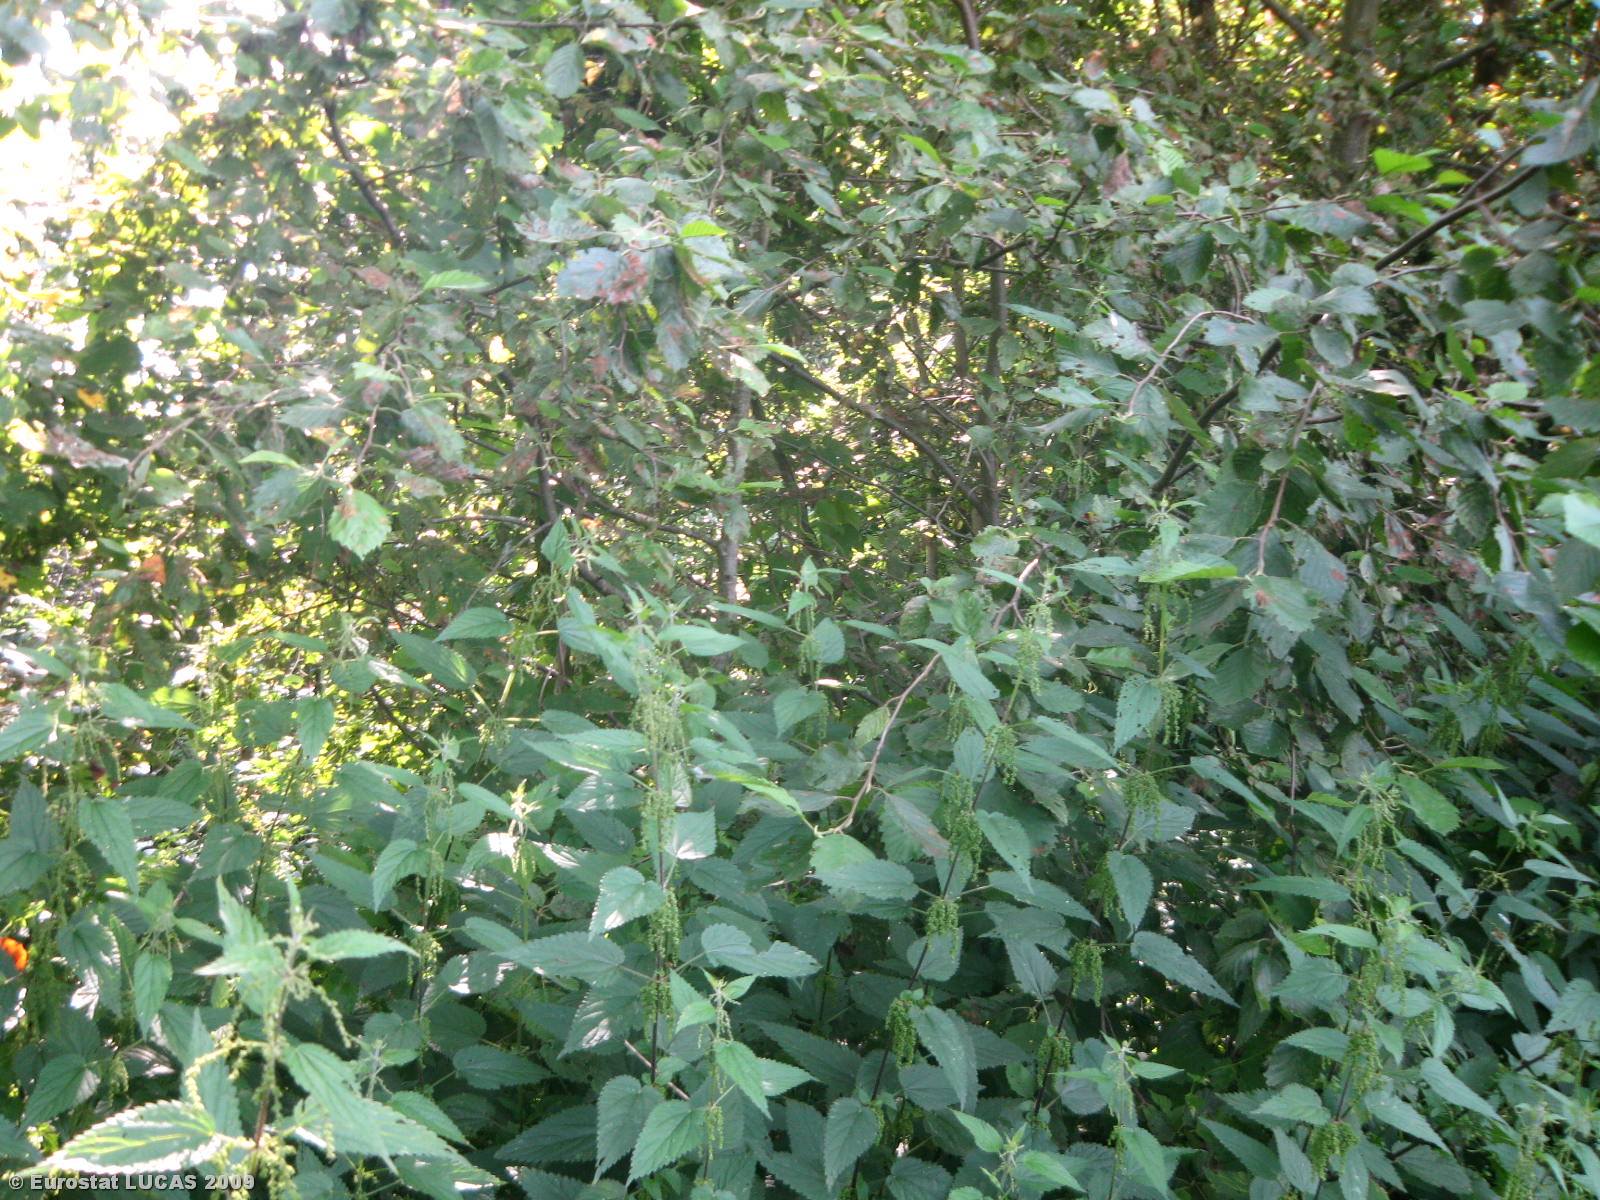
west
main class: Woodland
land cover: Broadleaved woodland
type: floodplain forest
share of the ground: > 75 %
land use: Forestry
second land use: Nature reserves
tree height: > 5 m
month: July
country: LT
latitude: 54.9634
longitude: 23.6246
